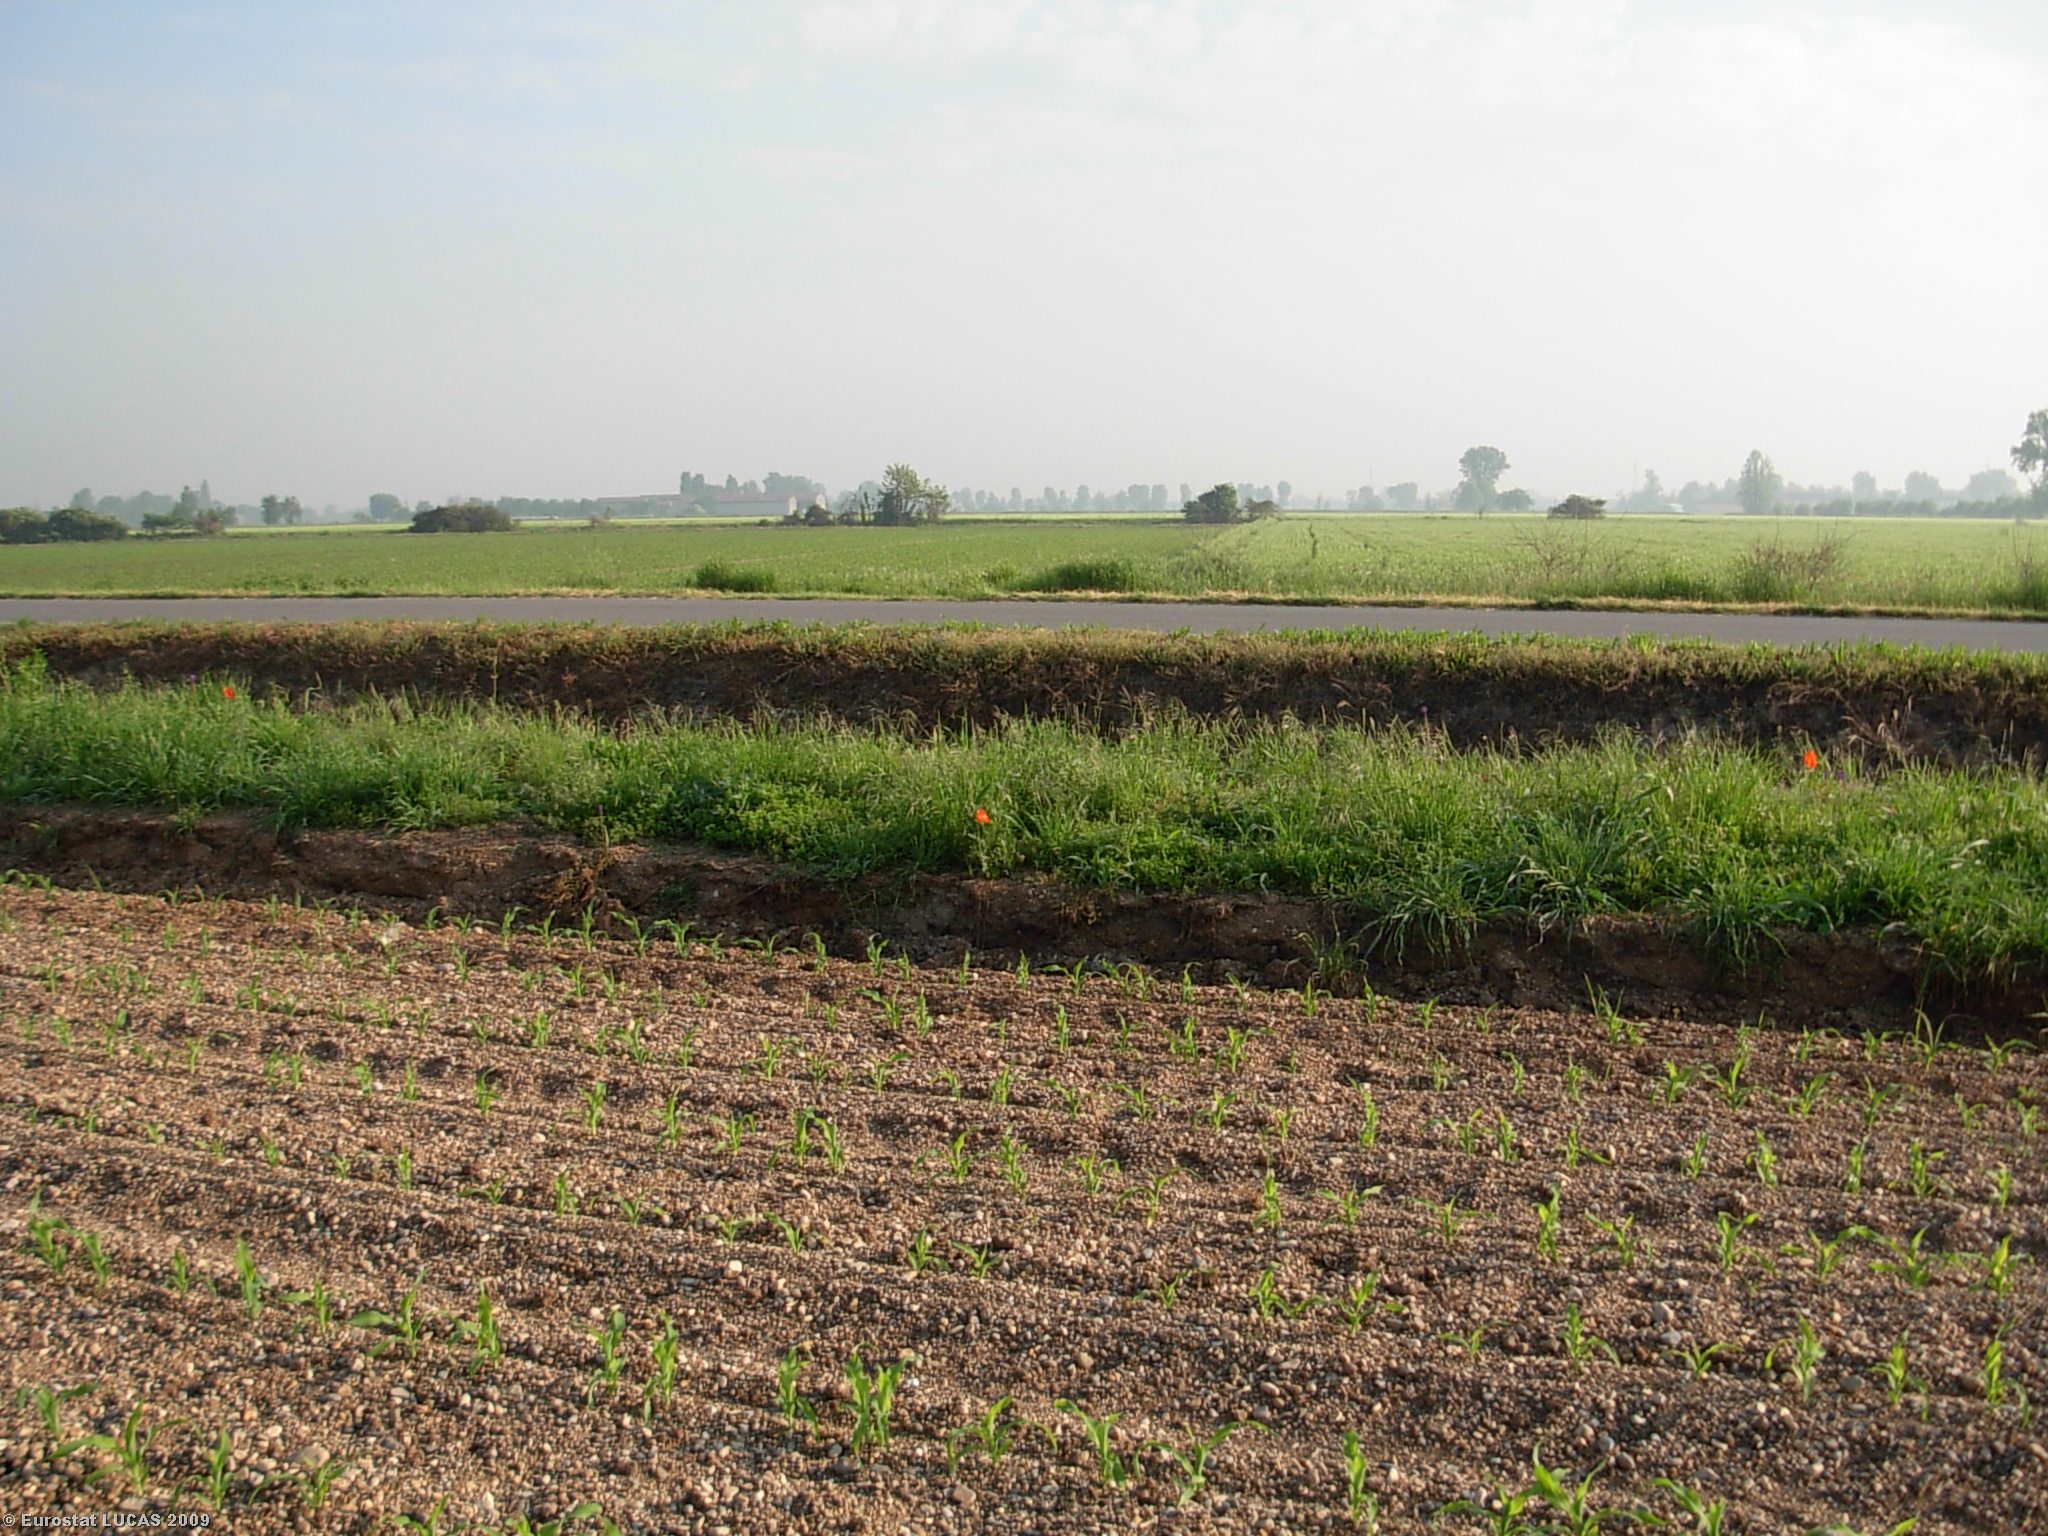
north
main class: Cropland
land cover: Maize
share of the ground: < 10 %
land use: Agriculture (excluding fallow land and kitchen gardens)
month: May
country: IT
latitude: 45.2695
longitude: 10.3435
